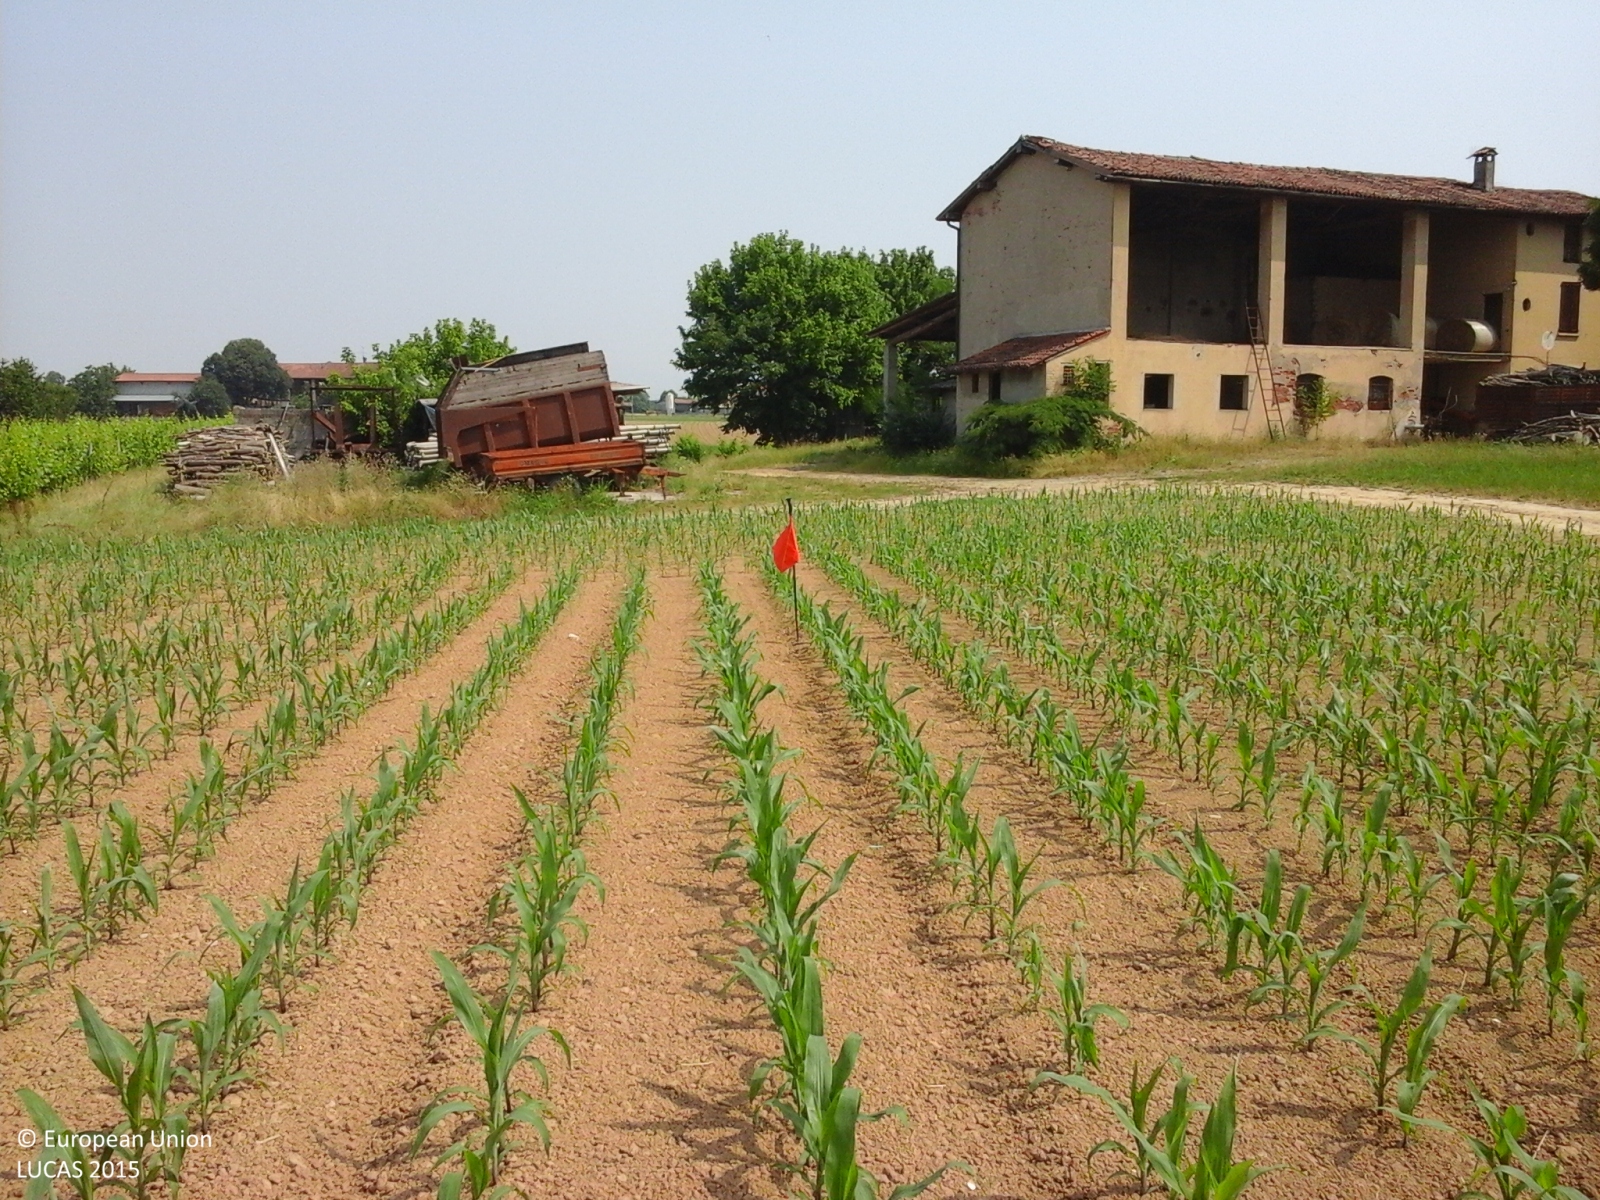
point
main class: Cropland
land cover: Maize
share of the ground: 25 - 50 %
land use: Agriculture (excluding fallow land and kitchen gardens)
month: June
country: IT
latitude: 45.4502
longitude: 10.1659
